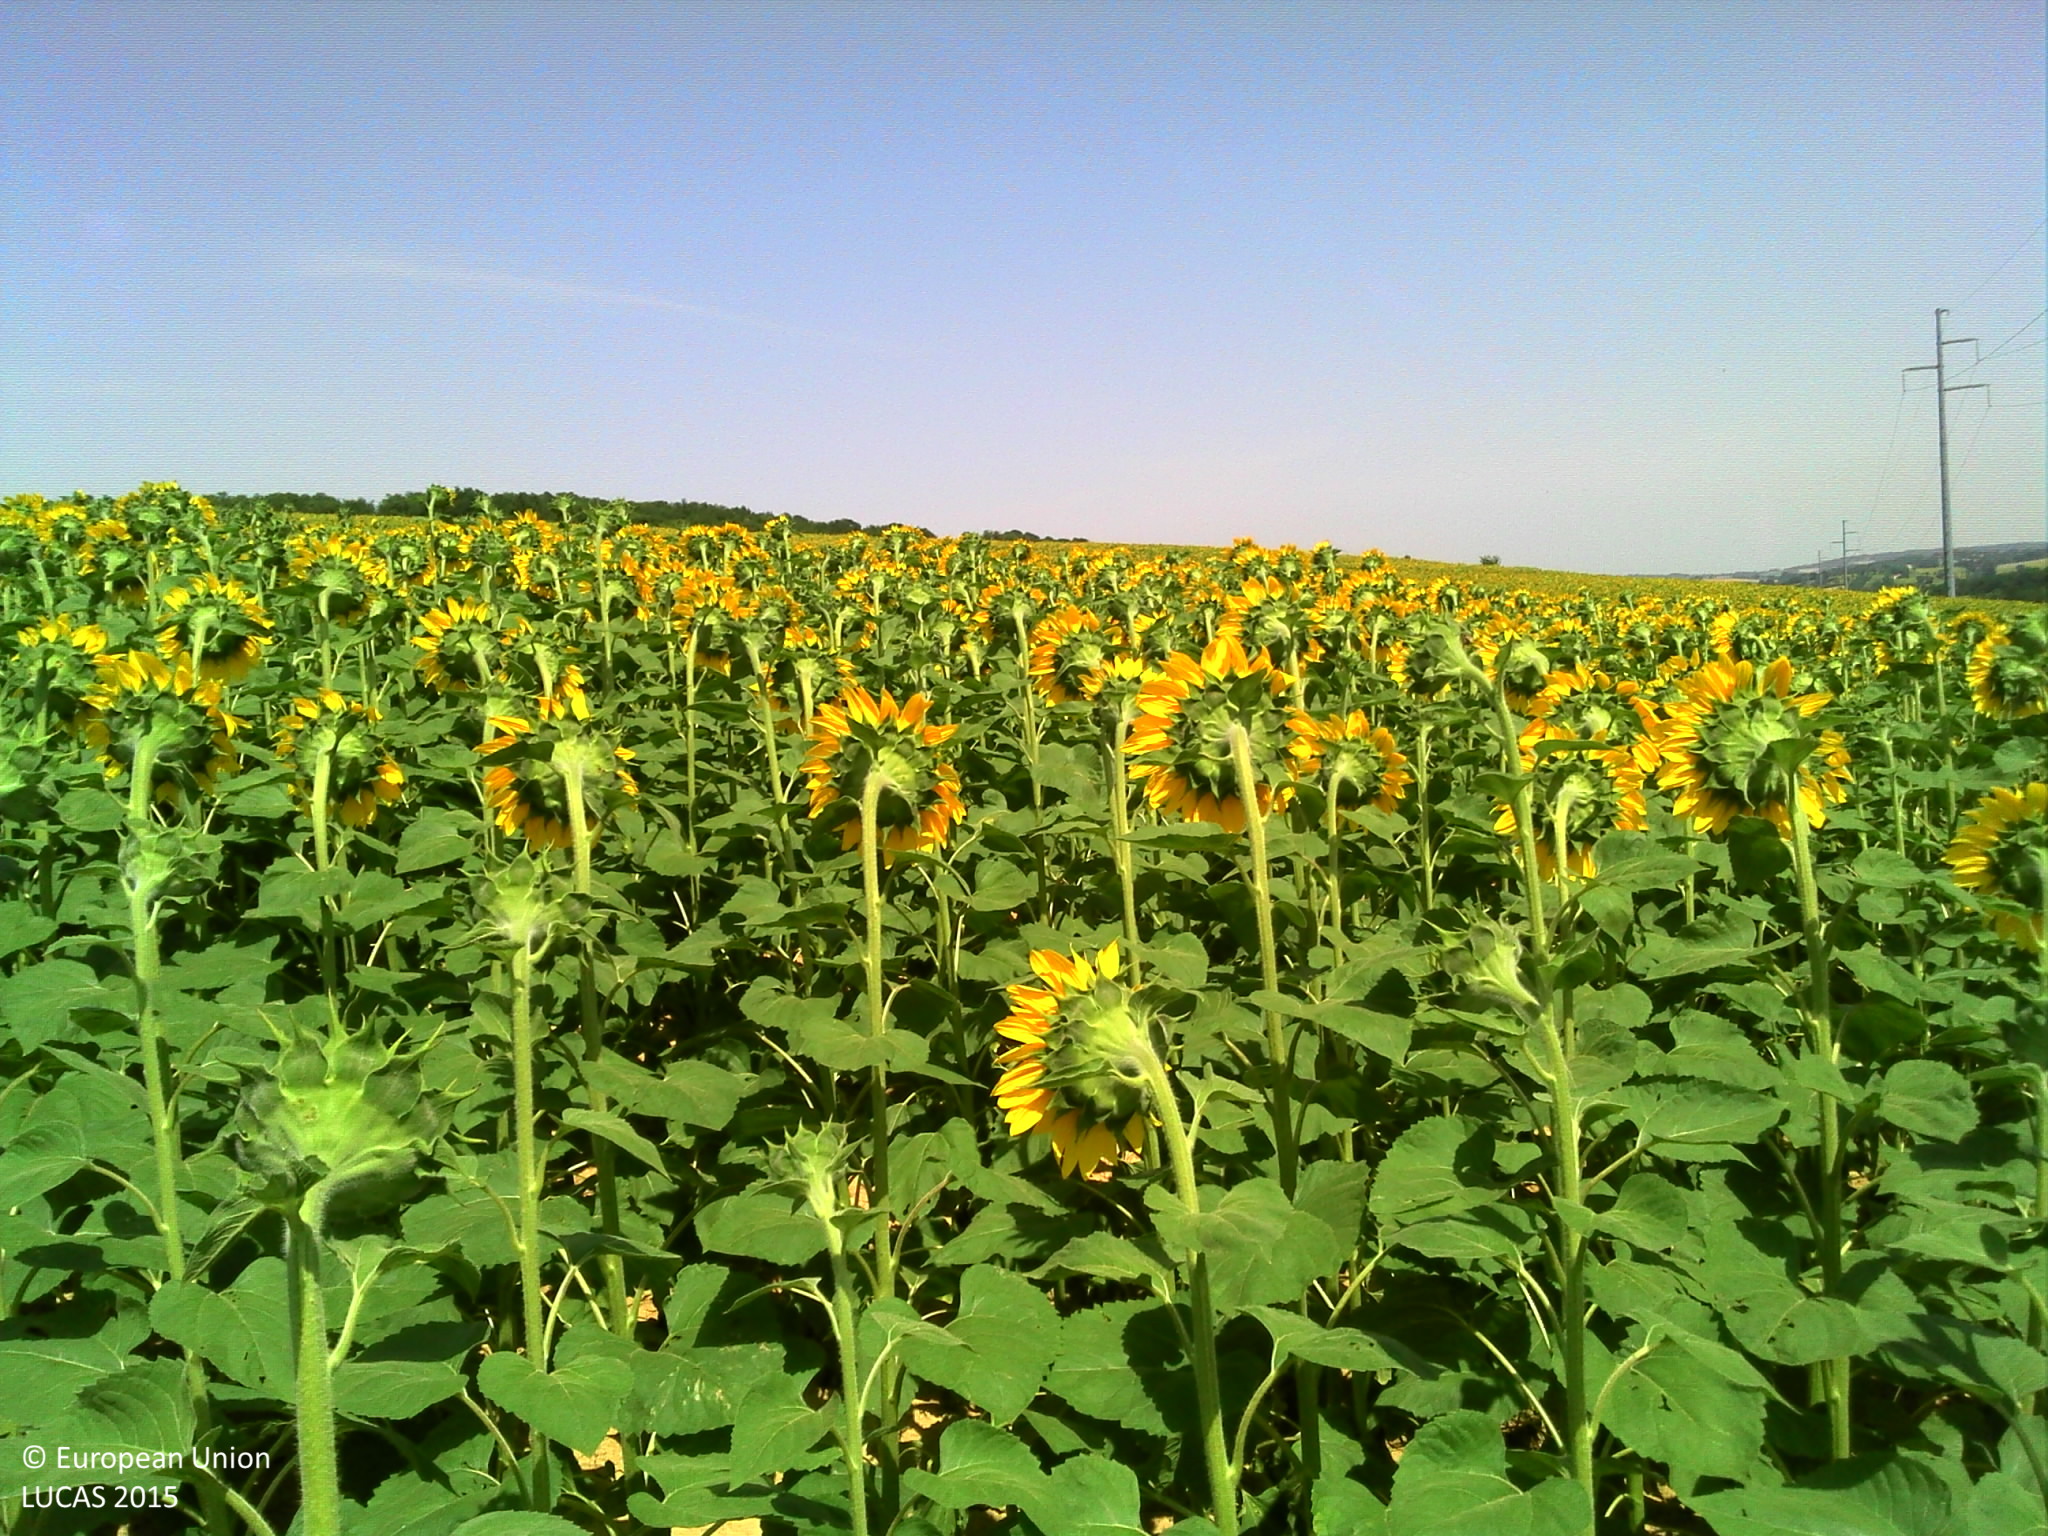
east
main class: Cropland
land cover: Sunflower
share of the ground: > 75 %
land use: Agriculture (excluding fallow land and kitchen gardens)
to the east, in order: Sunflower; Managed hedges; Sunflower; Lucerne
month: July
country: FR
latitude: 43.5375
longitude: 0.9543
